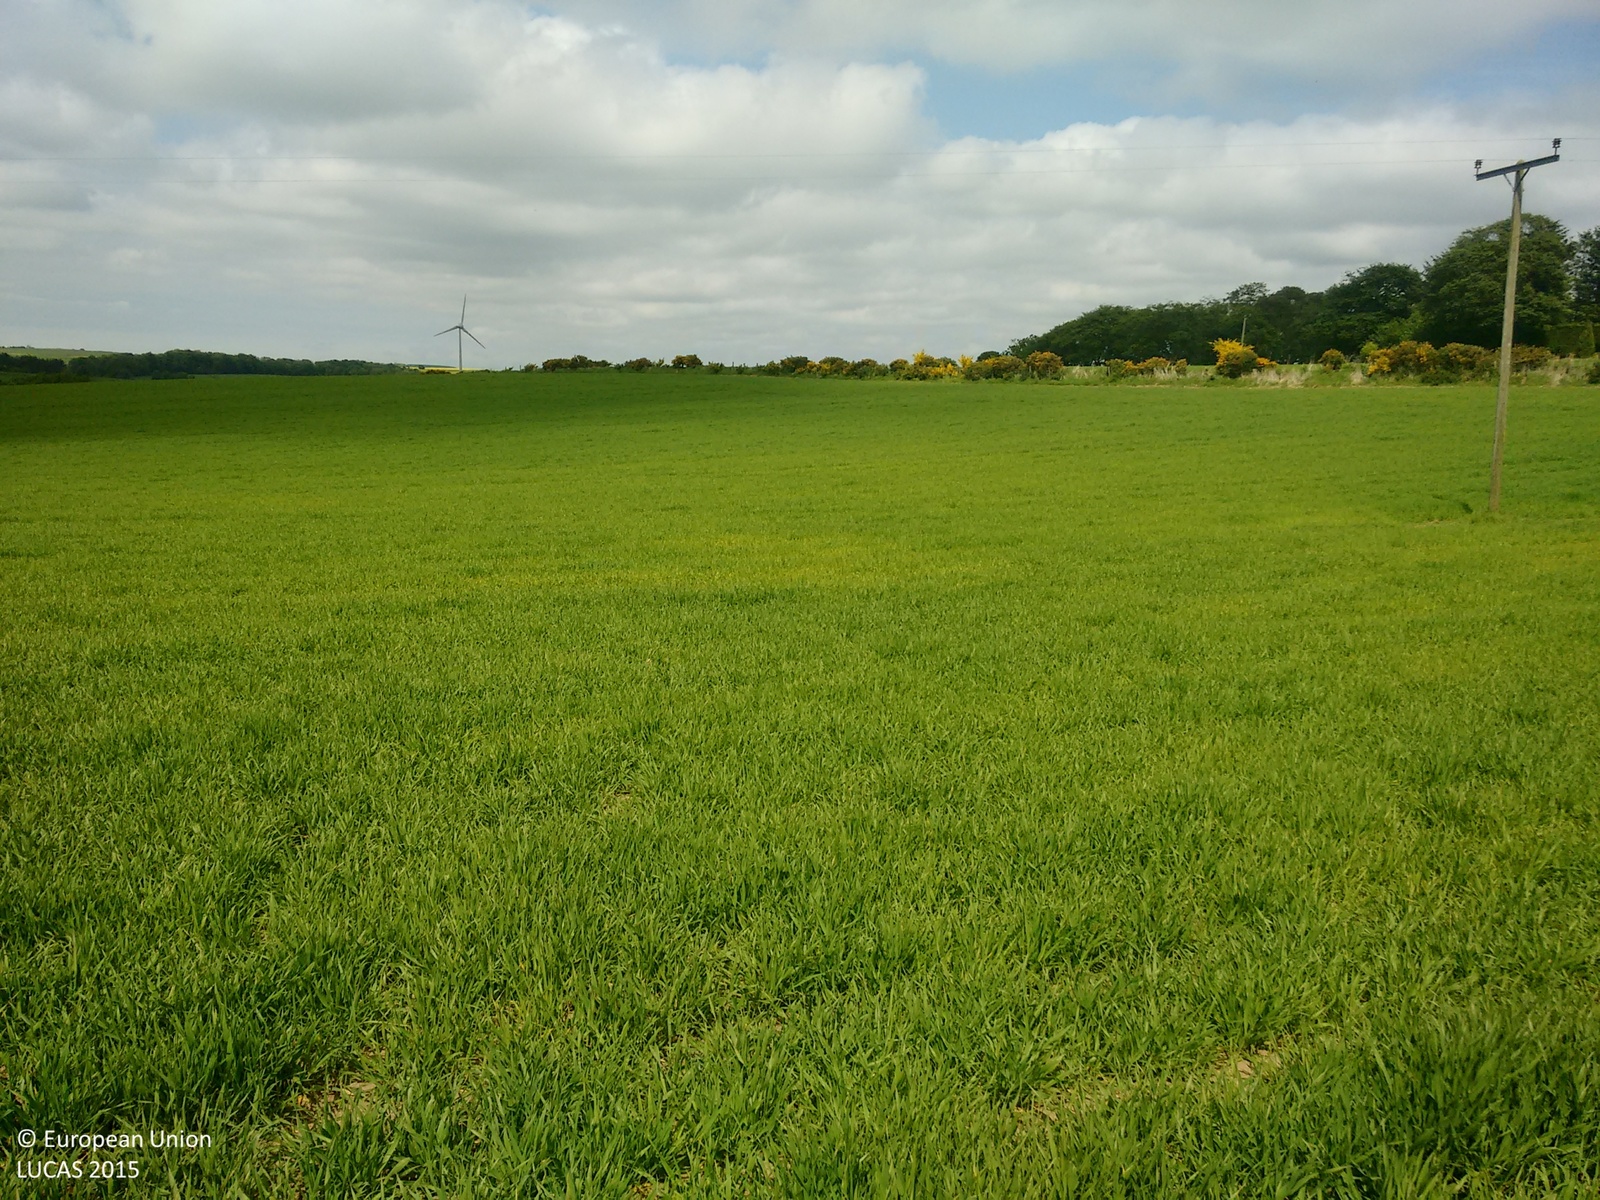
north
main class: Cropland
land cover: Barley
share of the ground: 50 - 75 %
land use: Agriculture (excluding fallow land and kitchen gardens)
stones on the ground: < 10 %
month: June
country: GB
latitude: 57.3132
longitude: -2.2188
